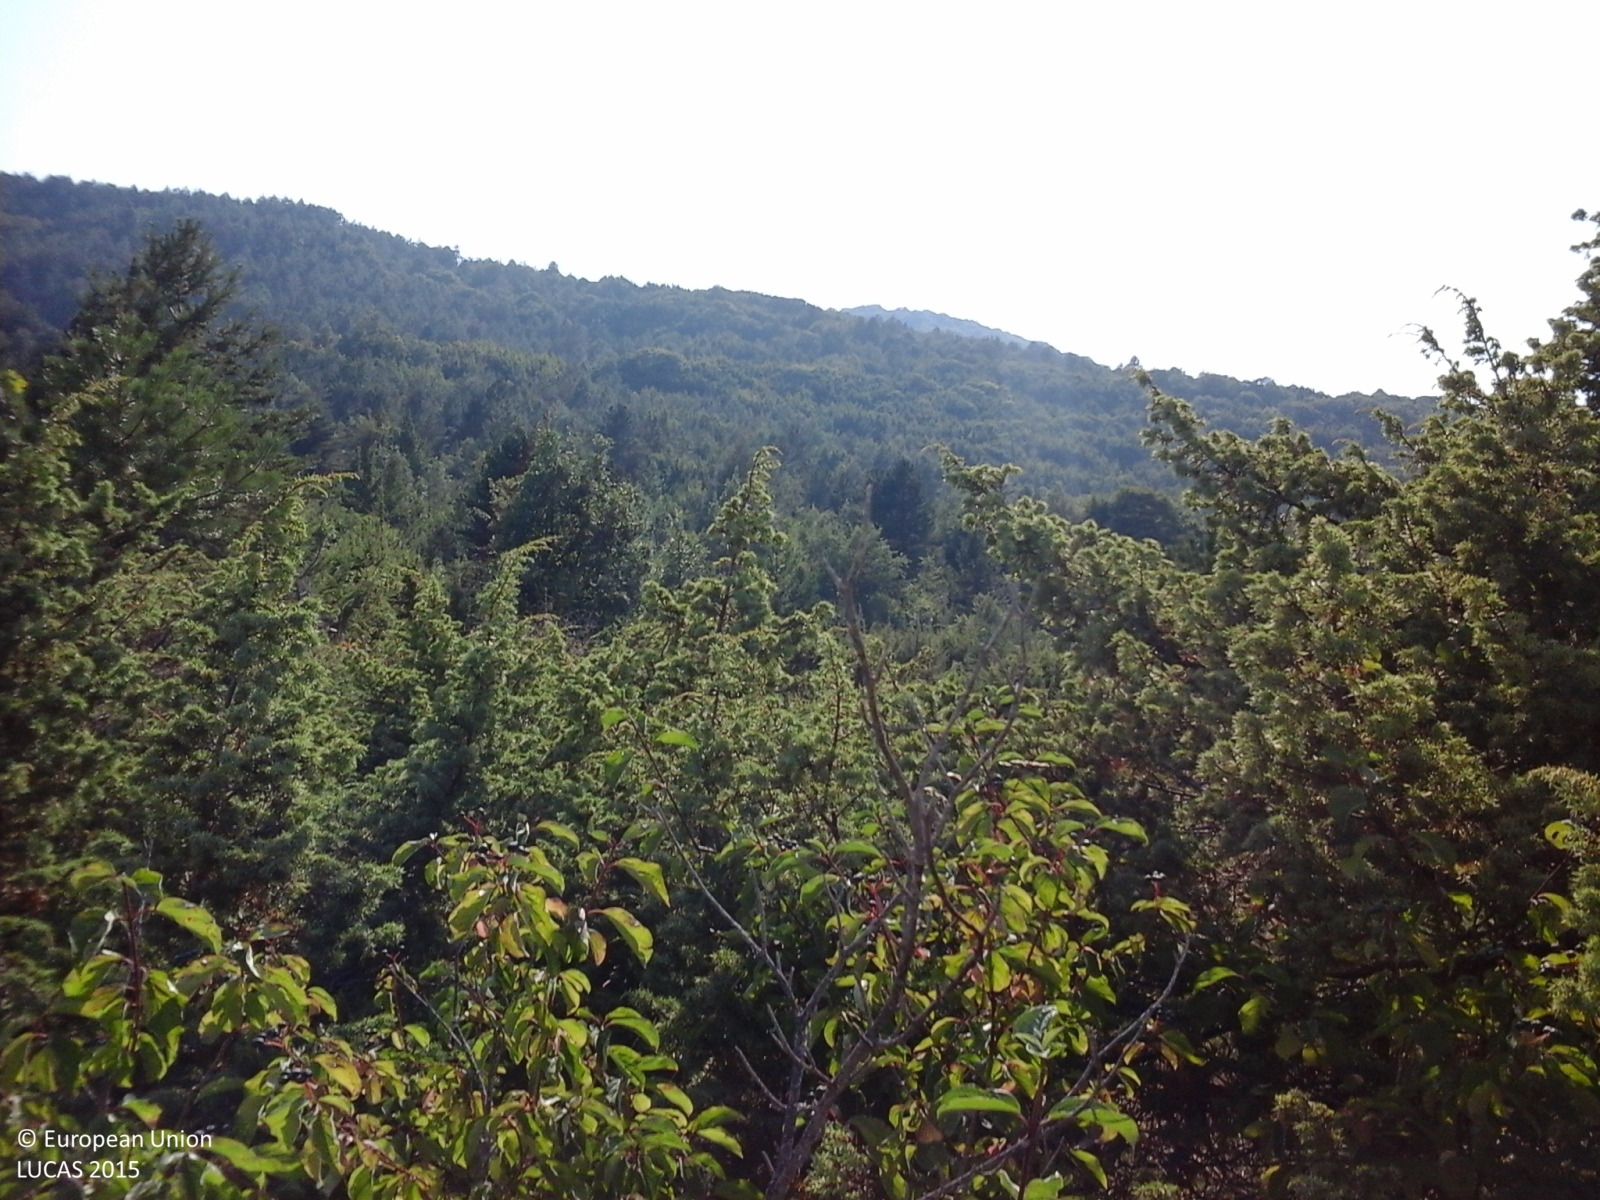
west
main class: Shrubland
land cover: Shrubland with sparse tree cover
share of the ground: > 75 %
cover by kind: shrubs 70 %, herbaceous plants 25 %, coniferous forest trees 5 %
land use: Agriculture (excluding fallow land and kitchen gardens)
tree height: < 5 m
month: August
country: IT
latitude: 42.9306
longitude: 13.1400
